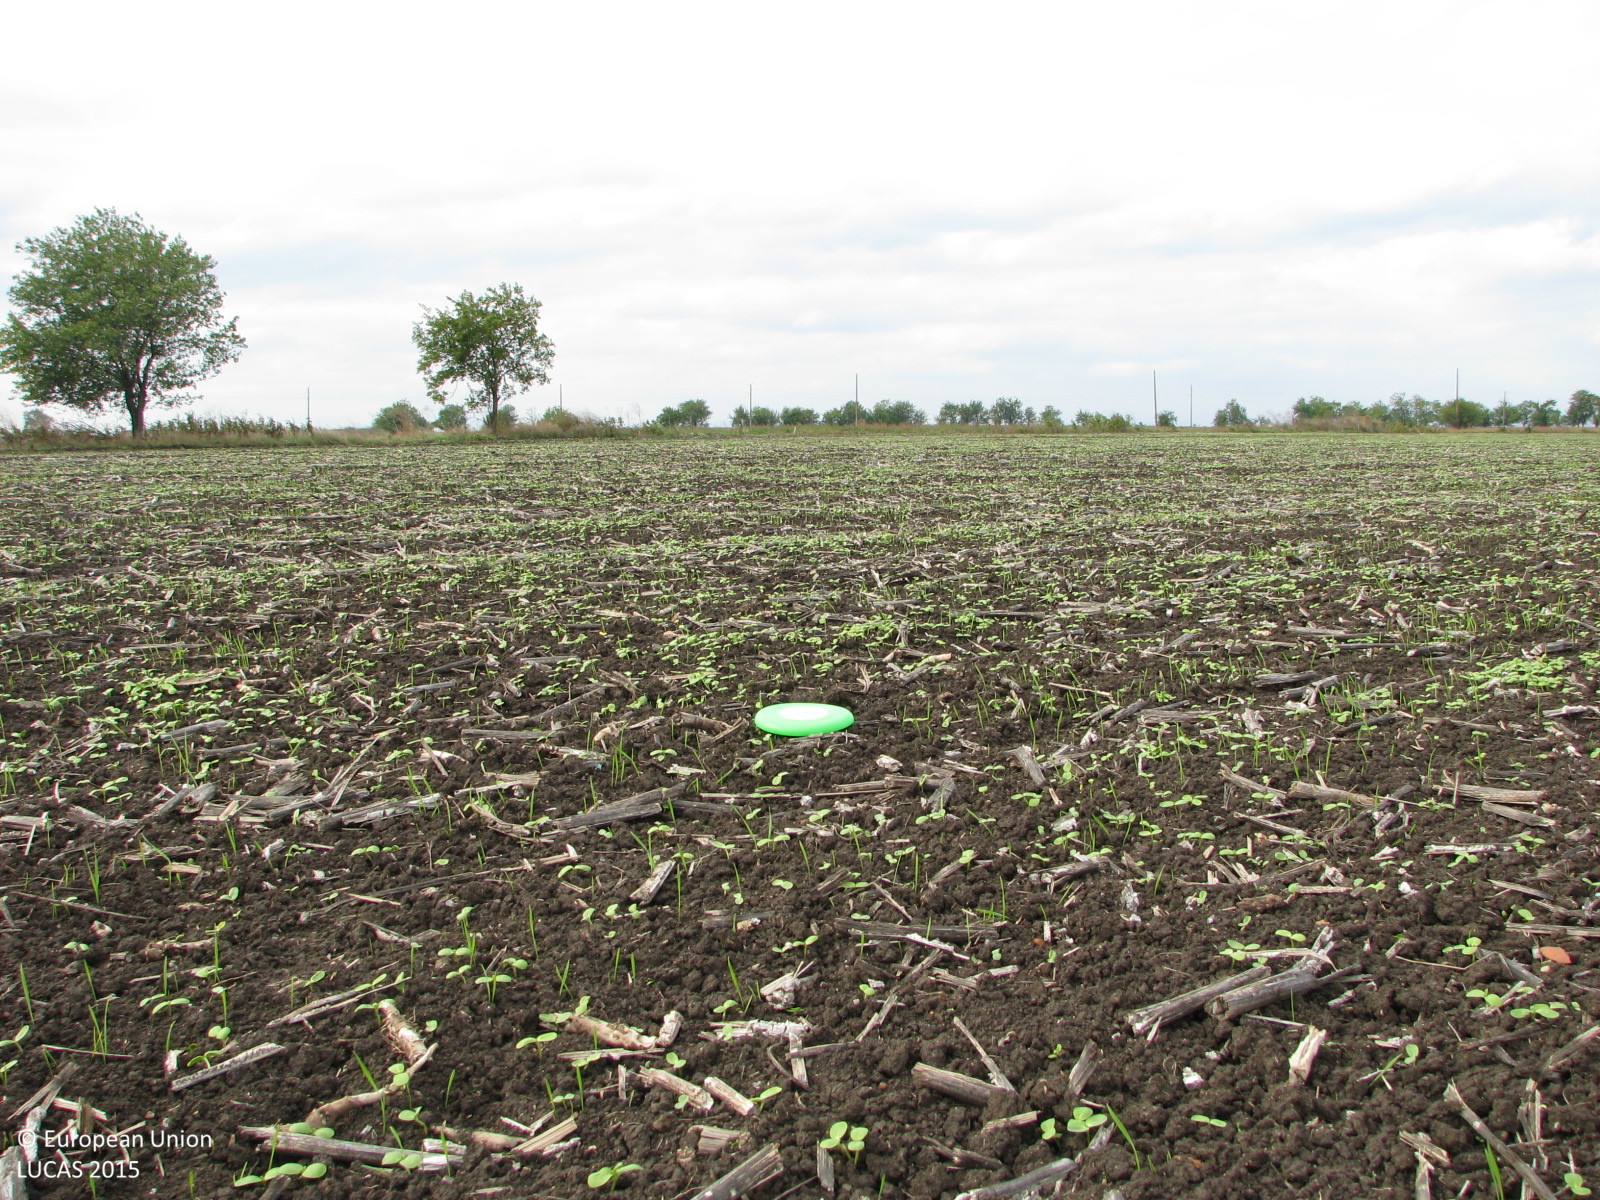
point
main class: Cropland
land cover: Sunflower
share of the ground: < 10 %
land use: Agriculture (excluding fallow land and kitchen gardens)
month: October
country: BG
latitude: 42.2892
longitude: 26.1261
